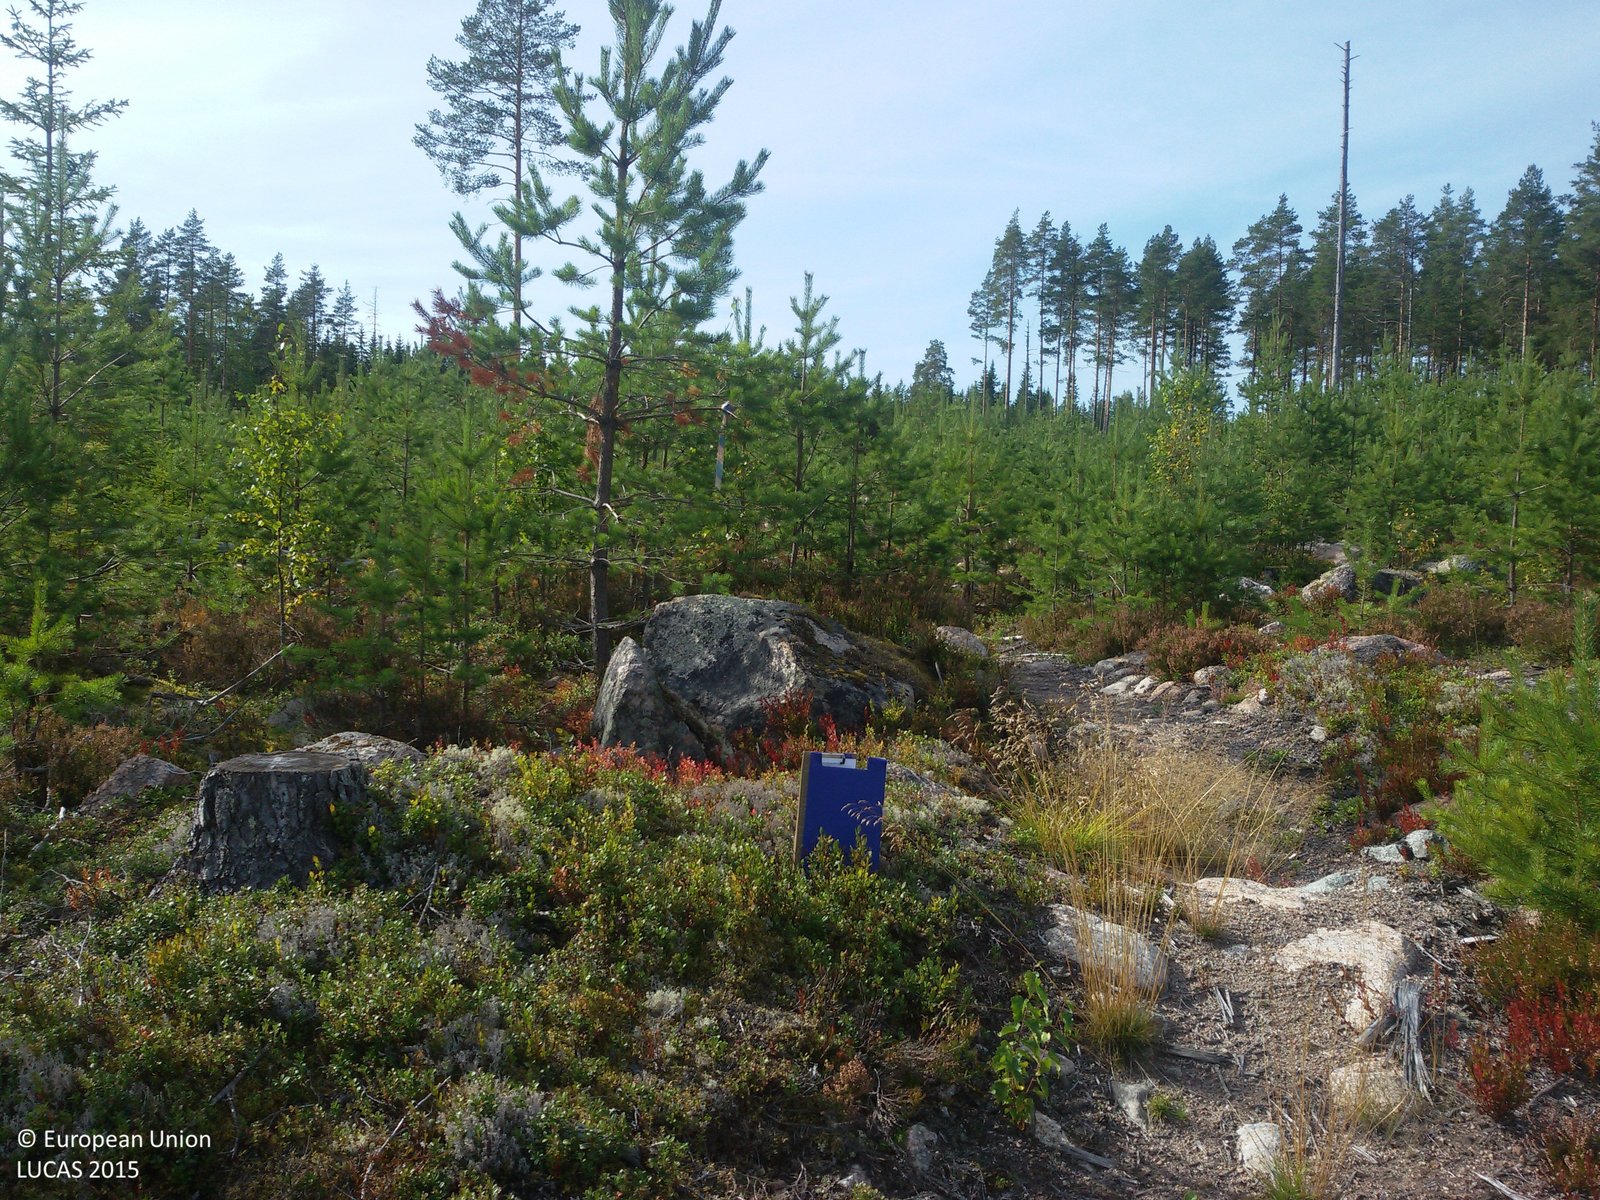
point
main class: Woodland
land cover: Pine dominated coniferous woodland
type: boreal forest
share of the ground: 50 - 75 %
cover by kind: coniferous forest trees 70 %, lichens and mosses 15 %, shrubs 10 %, herbaceous plants 5 %
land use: Forestry
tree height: < 5 m
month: September
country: SE
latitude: 61.0185
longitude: 15.3328
